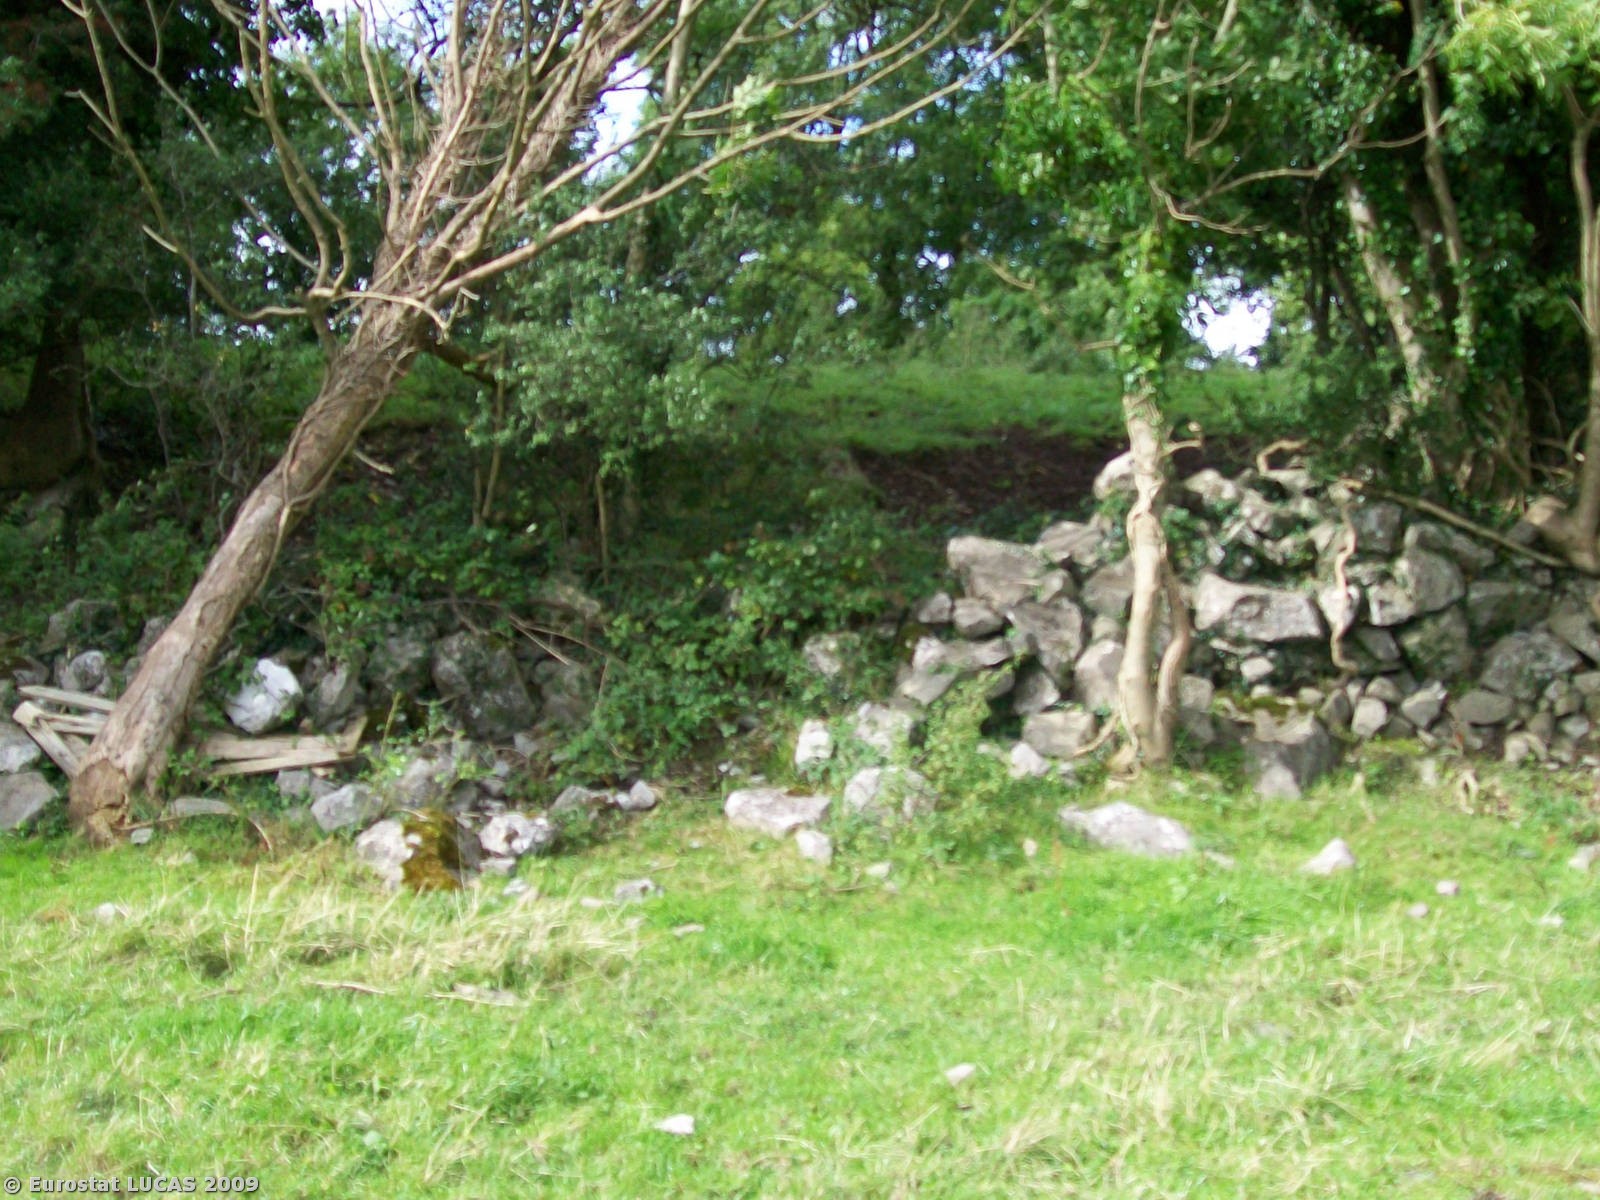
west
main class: Grassland
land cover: Grassland without tree/shrub cover
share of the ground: > 75 %
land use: Agriculture (excluding fallow land and kitchen gardens)
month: August
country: IE
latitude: 53.1200
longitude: -8.7461
